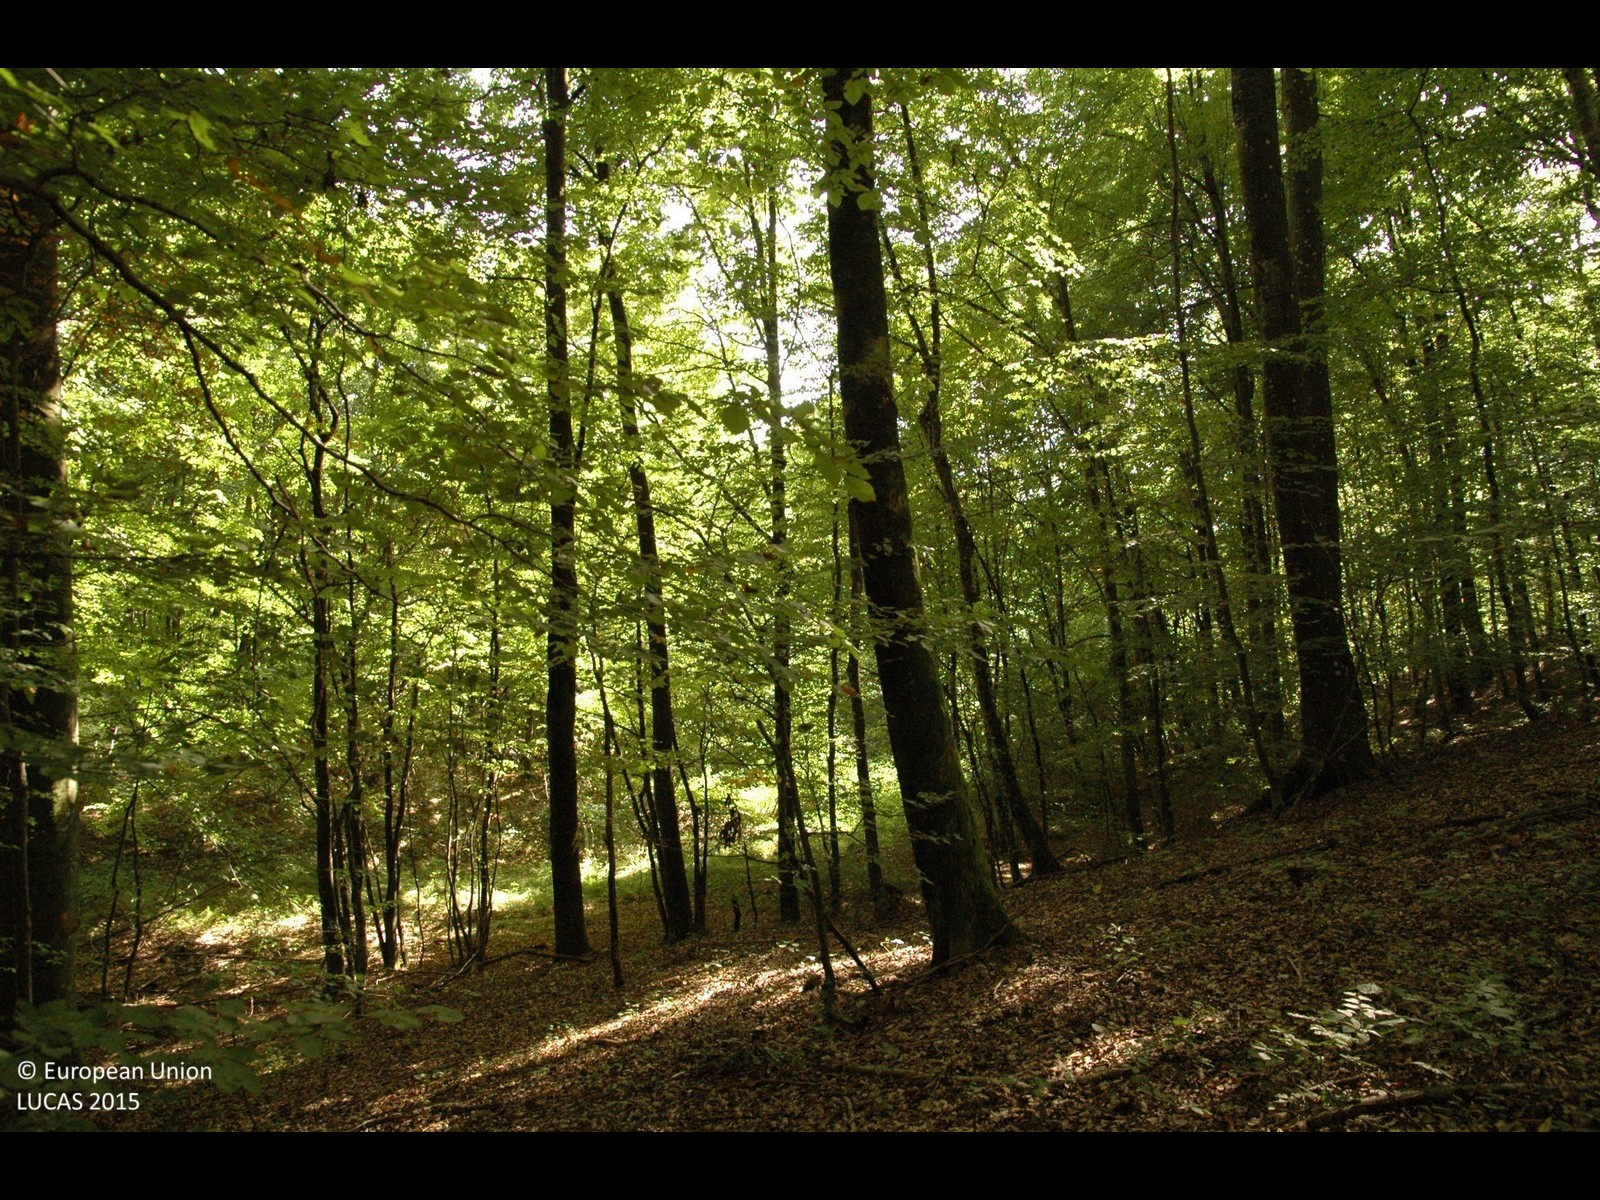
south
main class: Woodland
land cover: Broadleaved woodland
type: beech forest
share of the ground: > 75 %
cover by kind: broadleaved forest trees 100 %
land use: Forestry
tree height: > 5 m
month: September
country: HR
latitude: 45.5934
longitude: 15.8809
